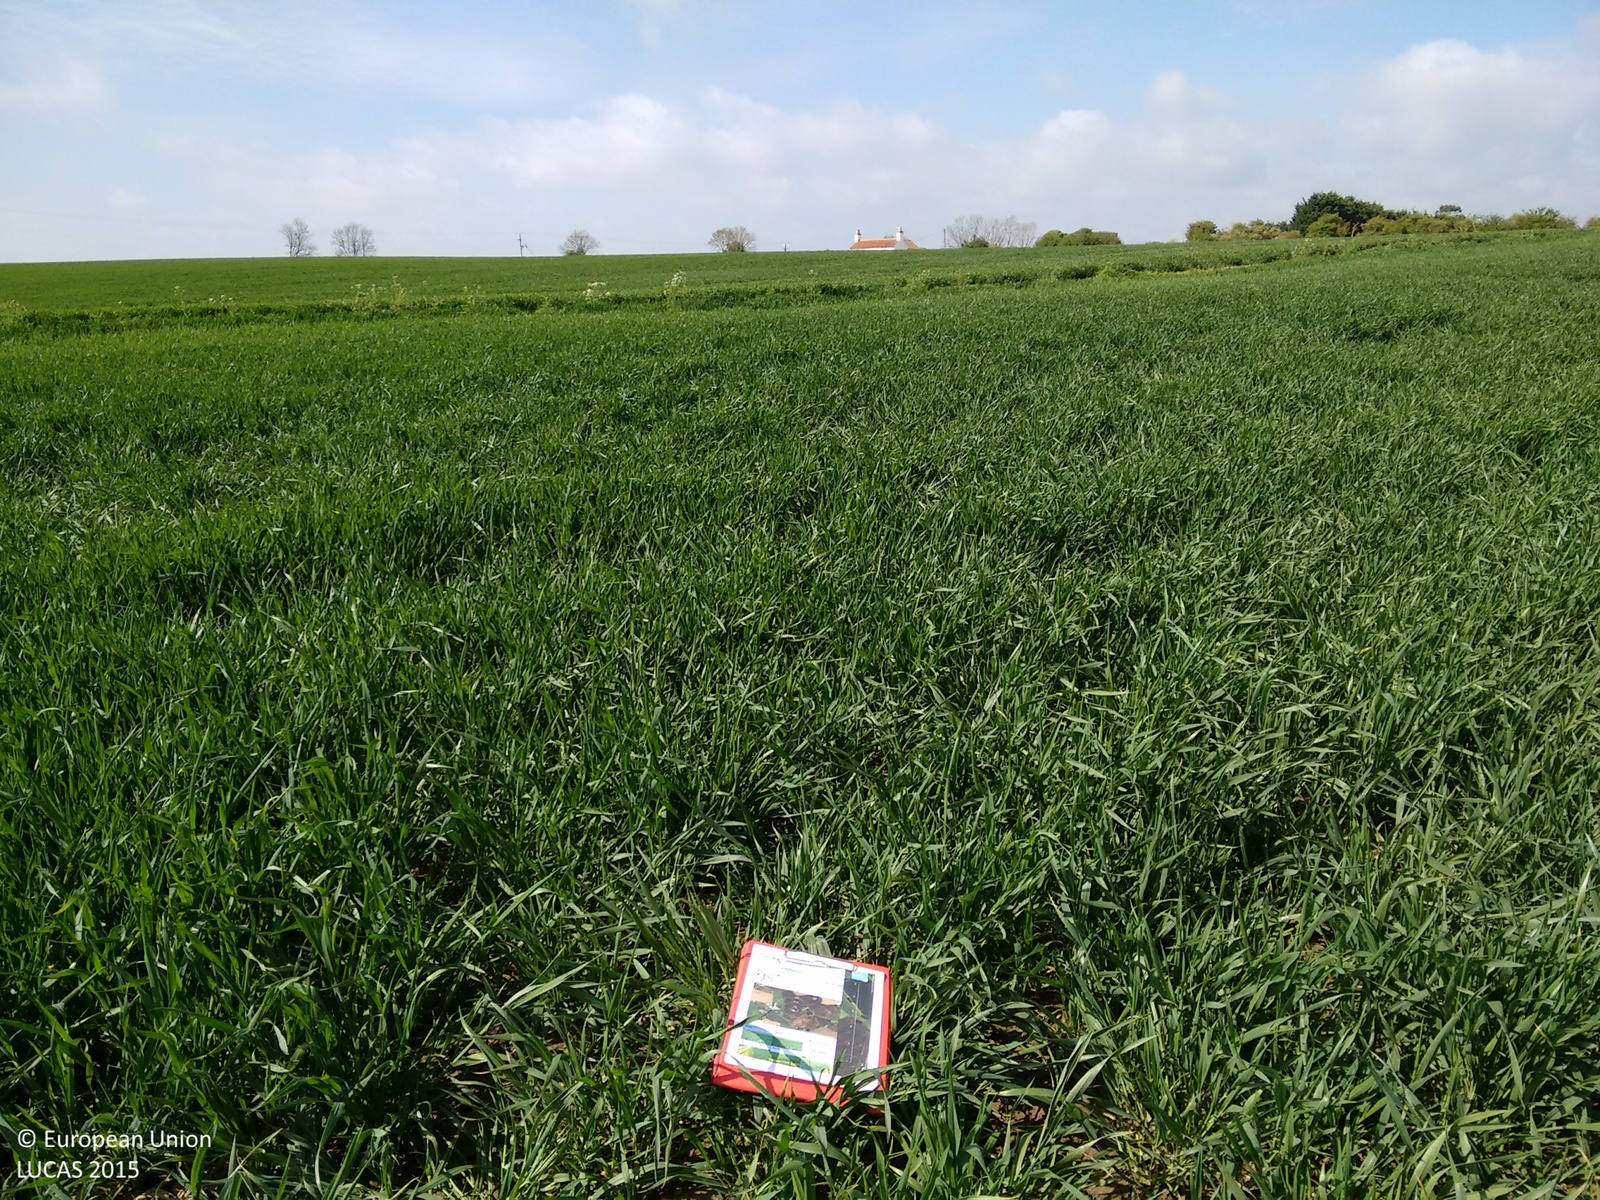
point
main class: Cropland
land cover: Barley
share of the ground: > 75 %
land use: Agriculture (excluding fallow land and kitchen gardens)
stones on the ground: < 10 %
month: May
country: GB
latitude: 53.2605
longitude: 0.2413
